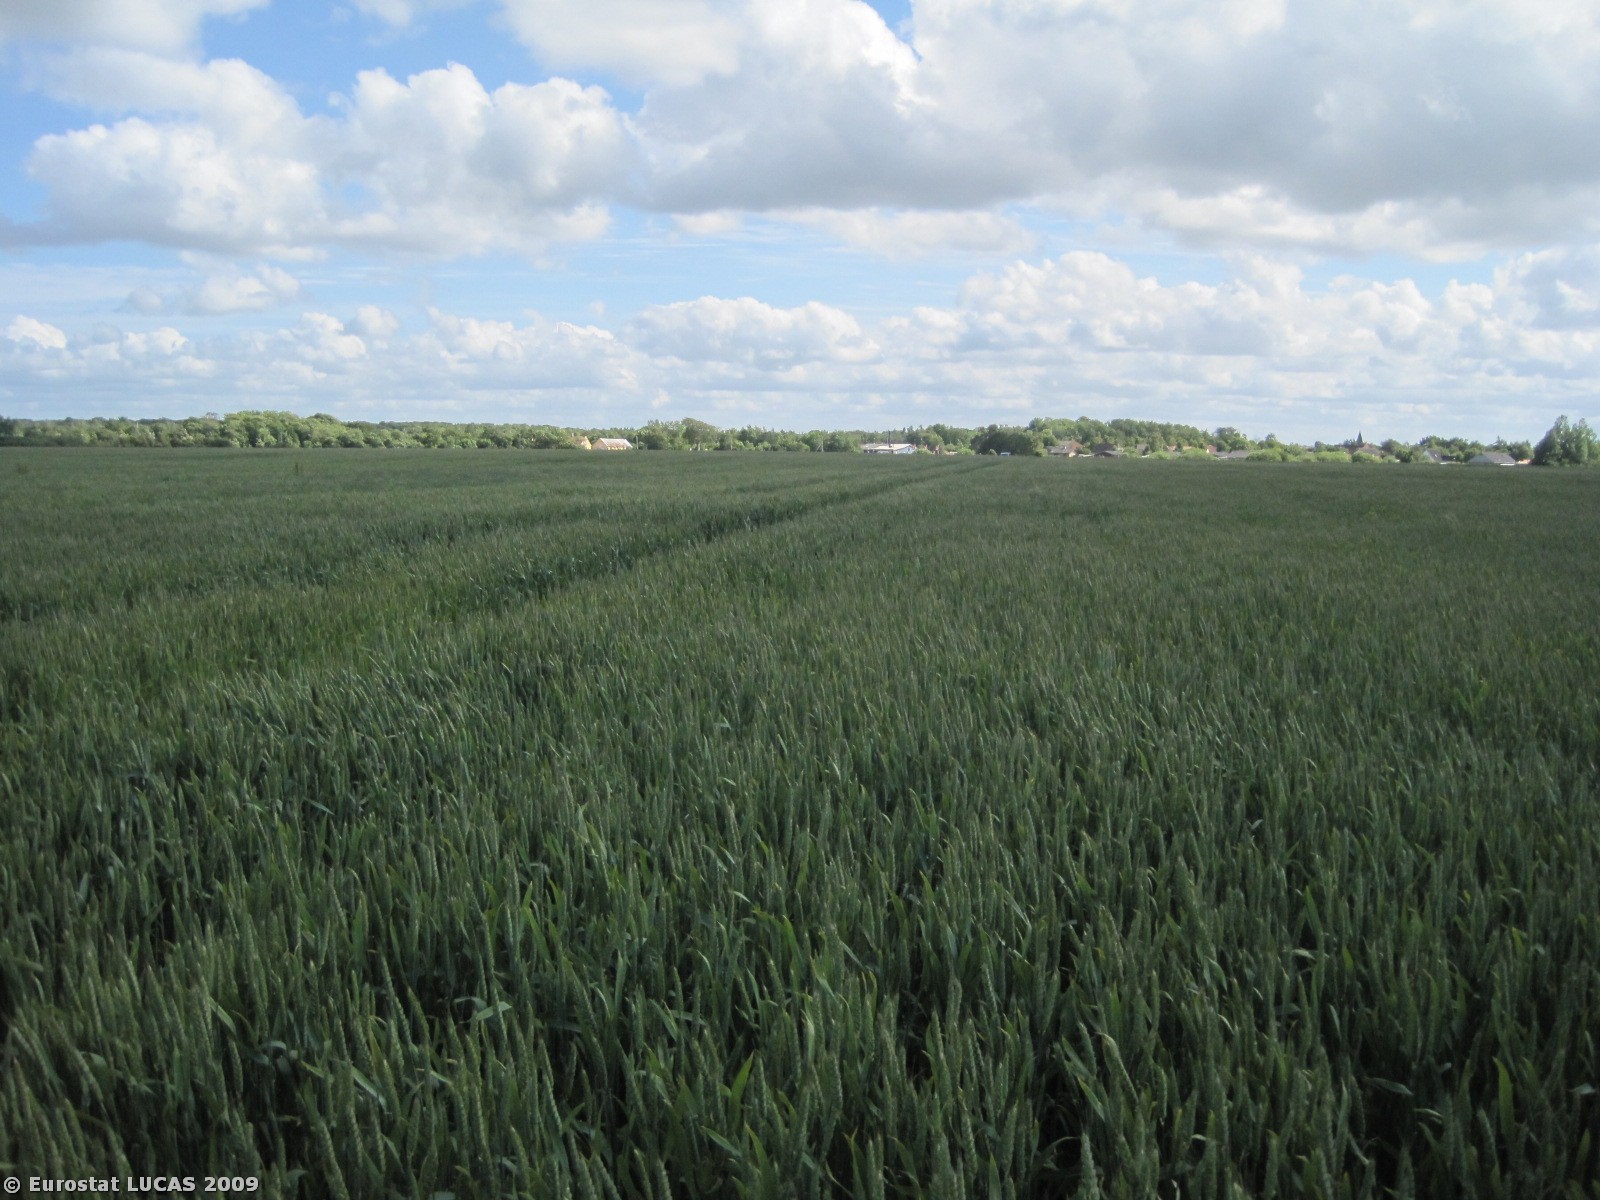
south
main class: Cropland
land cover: Common wheat
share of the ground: > 75 %
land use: Agriculture (excluding fallow land and kitchen gardens)
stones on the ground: < 10 %
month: June
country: DK
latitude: 57.1581
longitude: 9.6864
